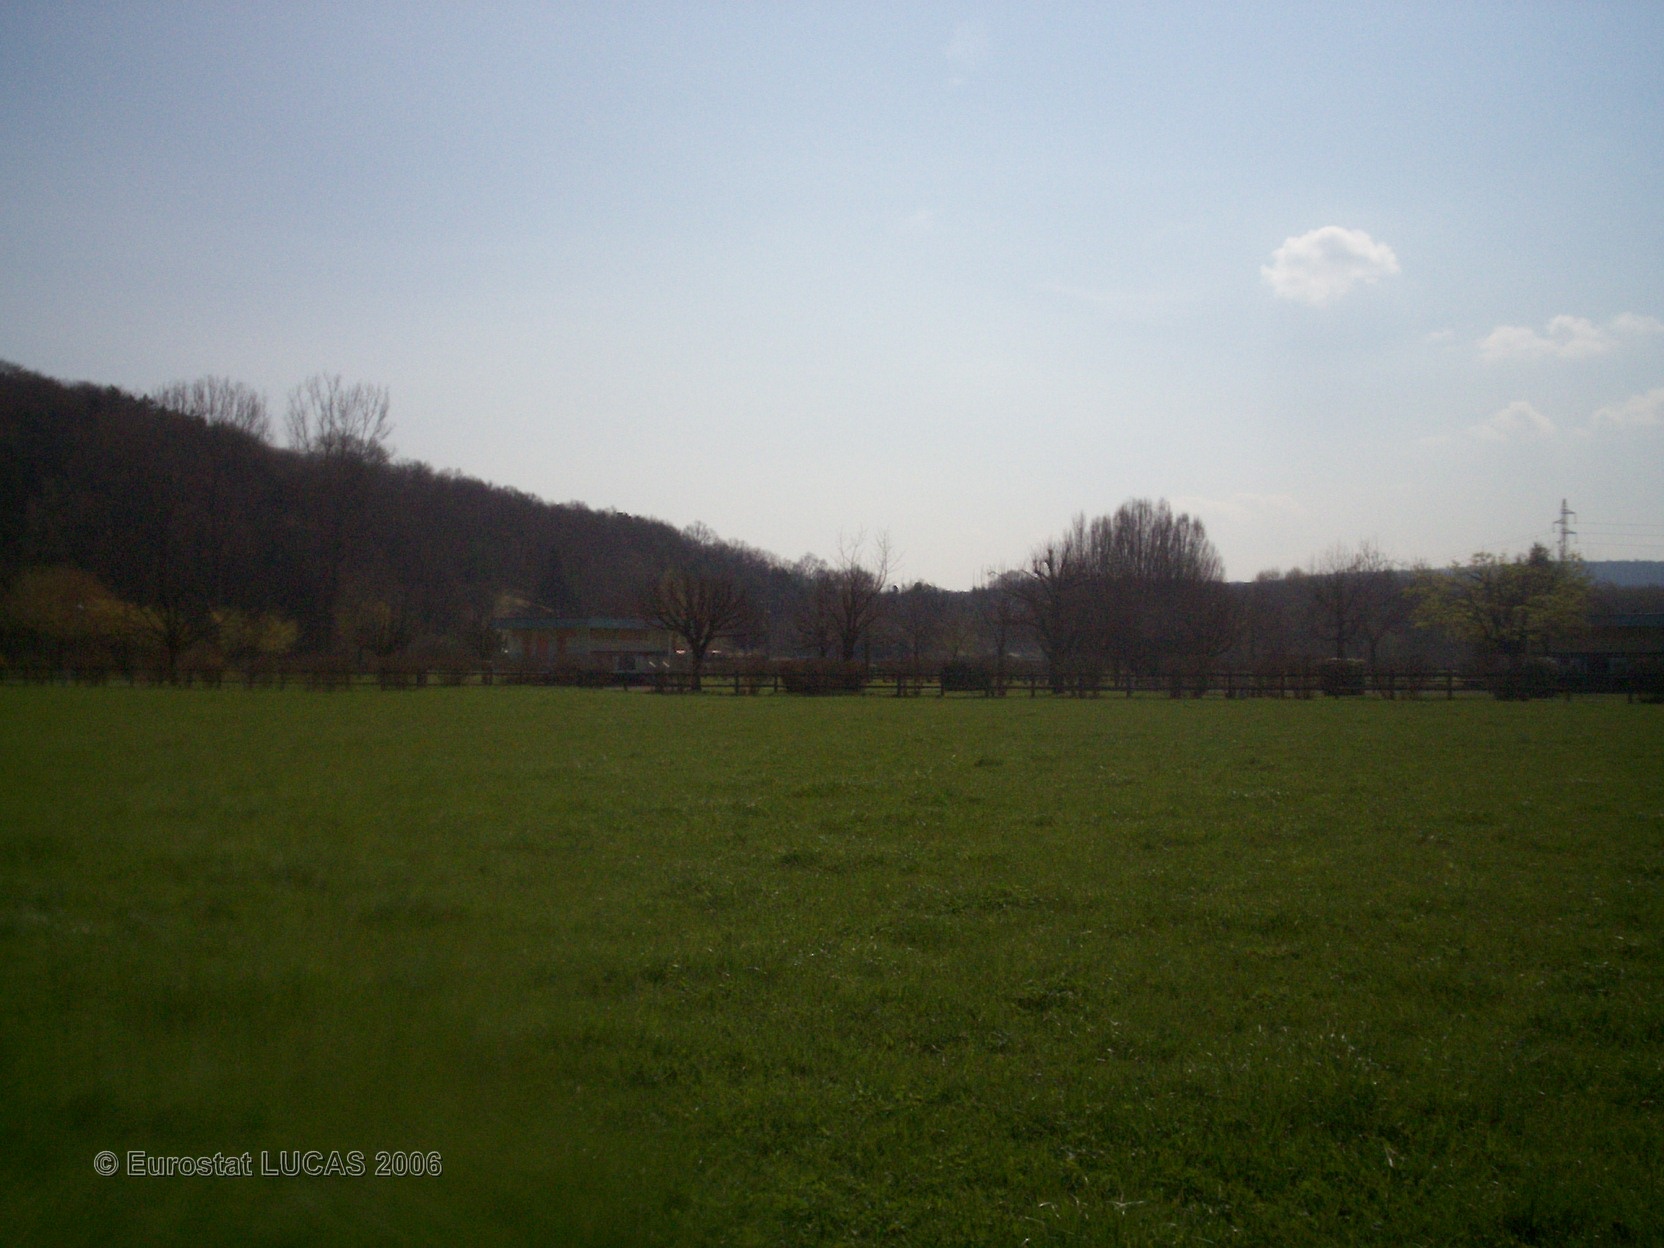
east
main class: Grassland
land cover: Grassland without tree/shrub cover
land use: Agriculture (excluding fallow land and kitchen gardens)
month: April
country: FR
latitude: 47.4568
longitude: 6.8050
